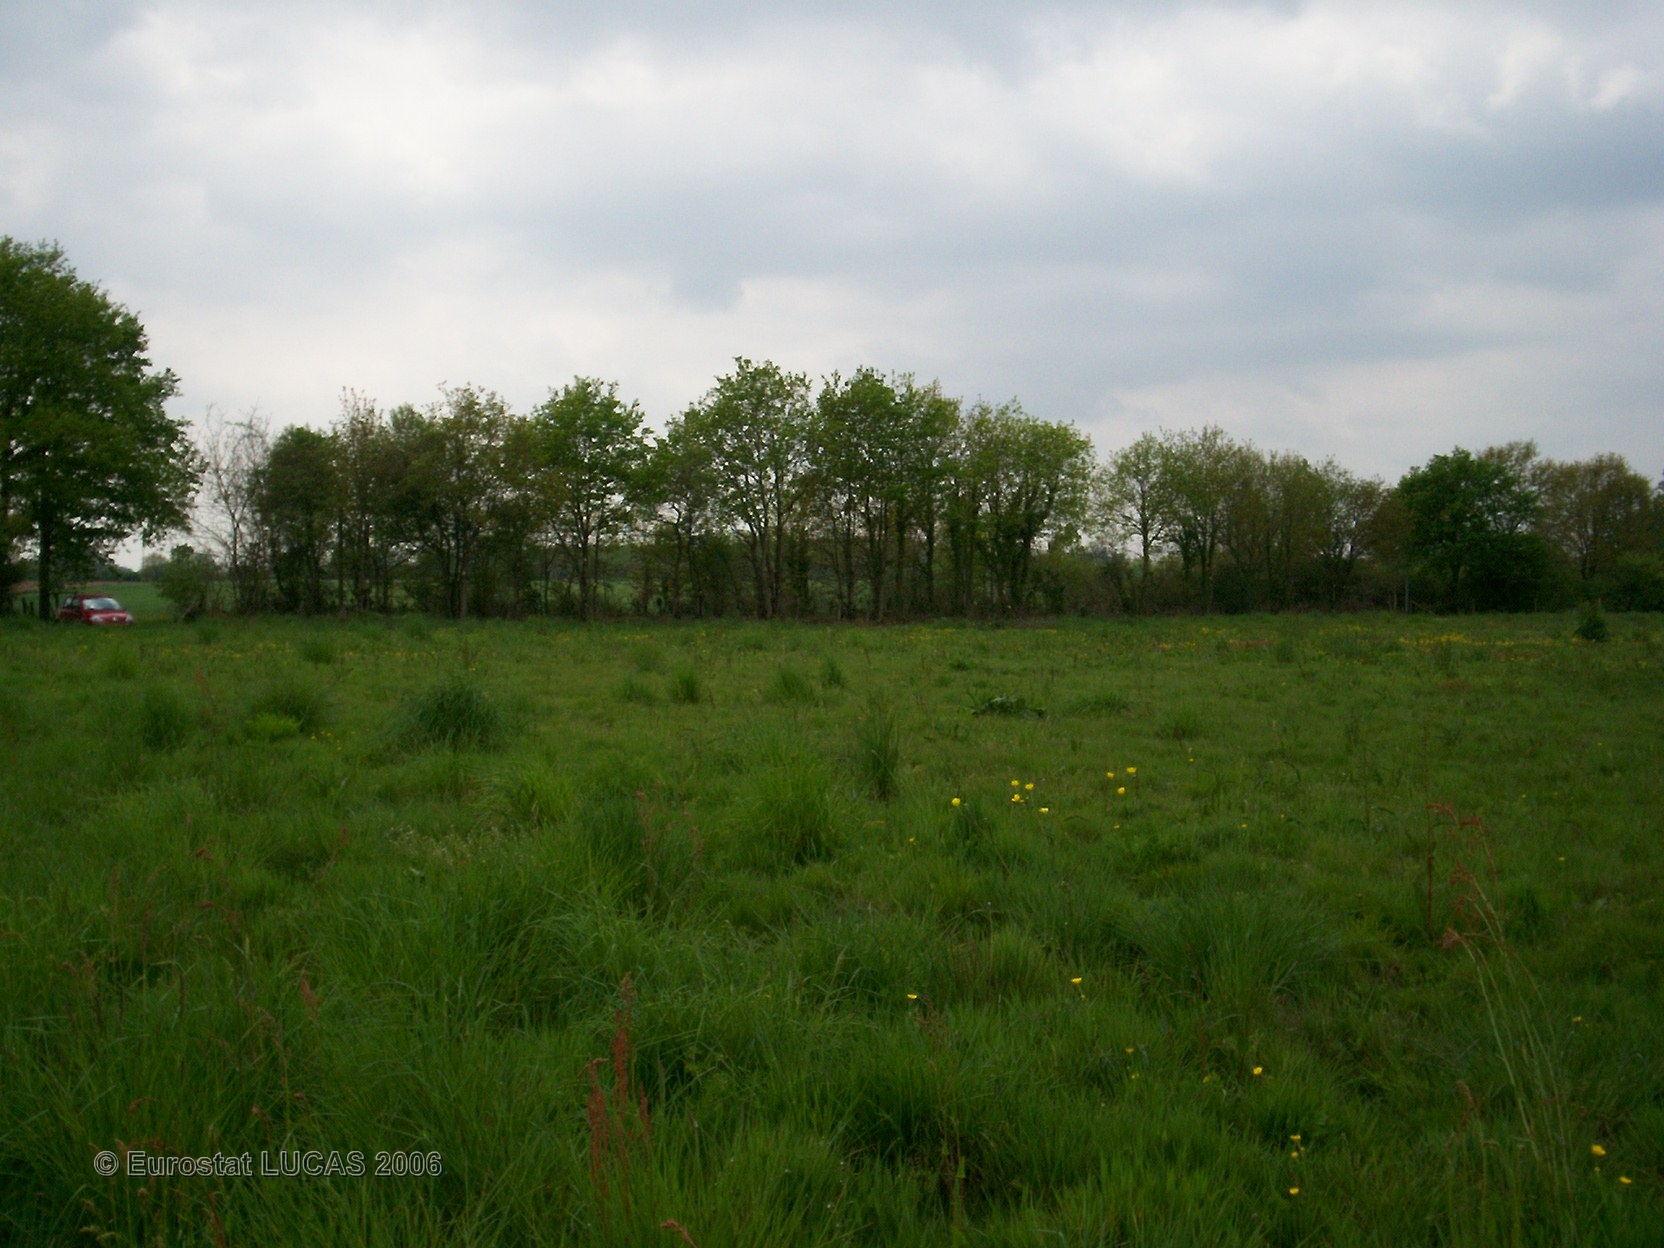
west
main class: Grassland
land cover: Grassland without tree/shrub cover
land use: Agriculture (excluding fallow land and kitchen gardens)
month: May
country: FR
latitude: 47.5213
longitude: -2.2313
